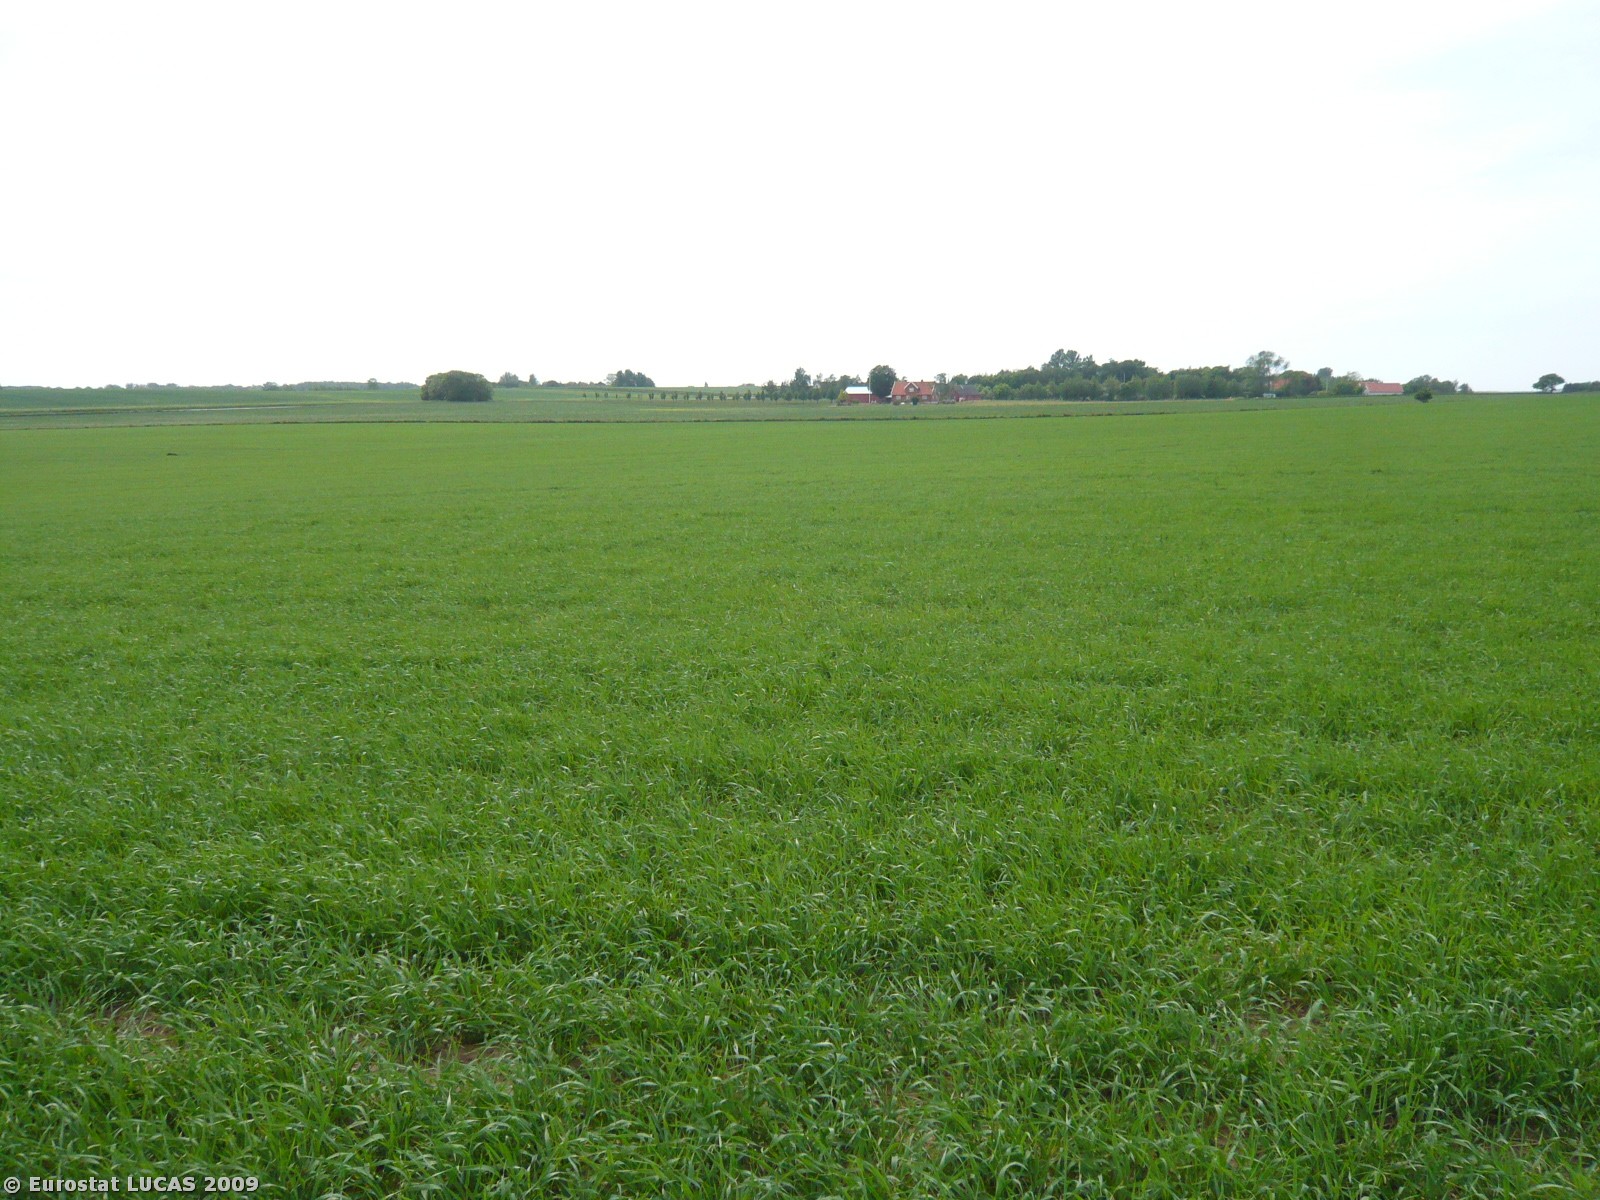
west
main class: Cropland
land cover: Barley
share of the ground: > 75 %
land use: Agriculture (excluding fallow land and kitchen gardens)
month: June
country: DK
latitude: 55.2287
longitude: 11.2725
